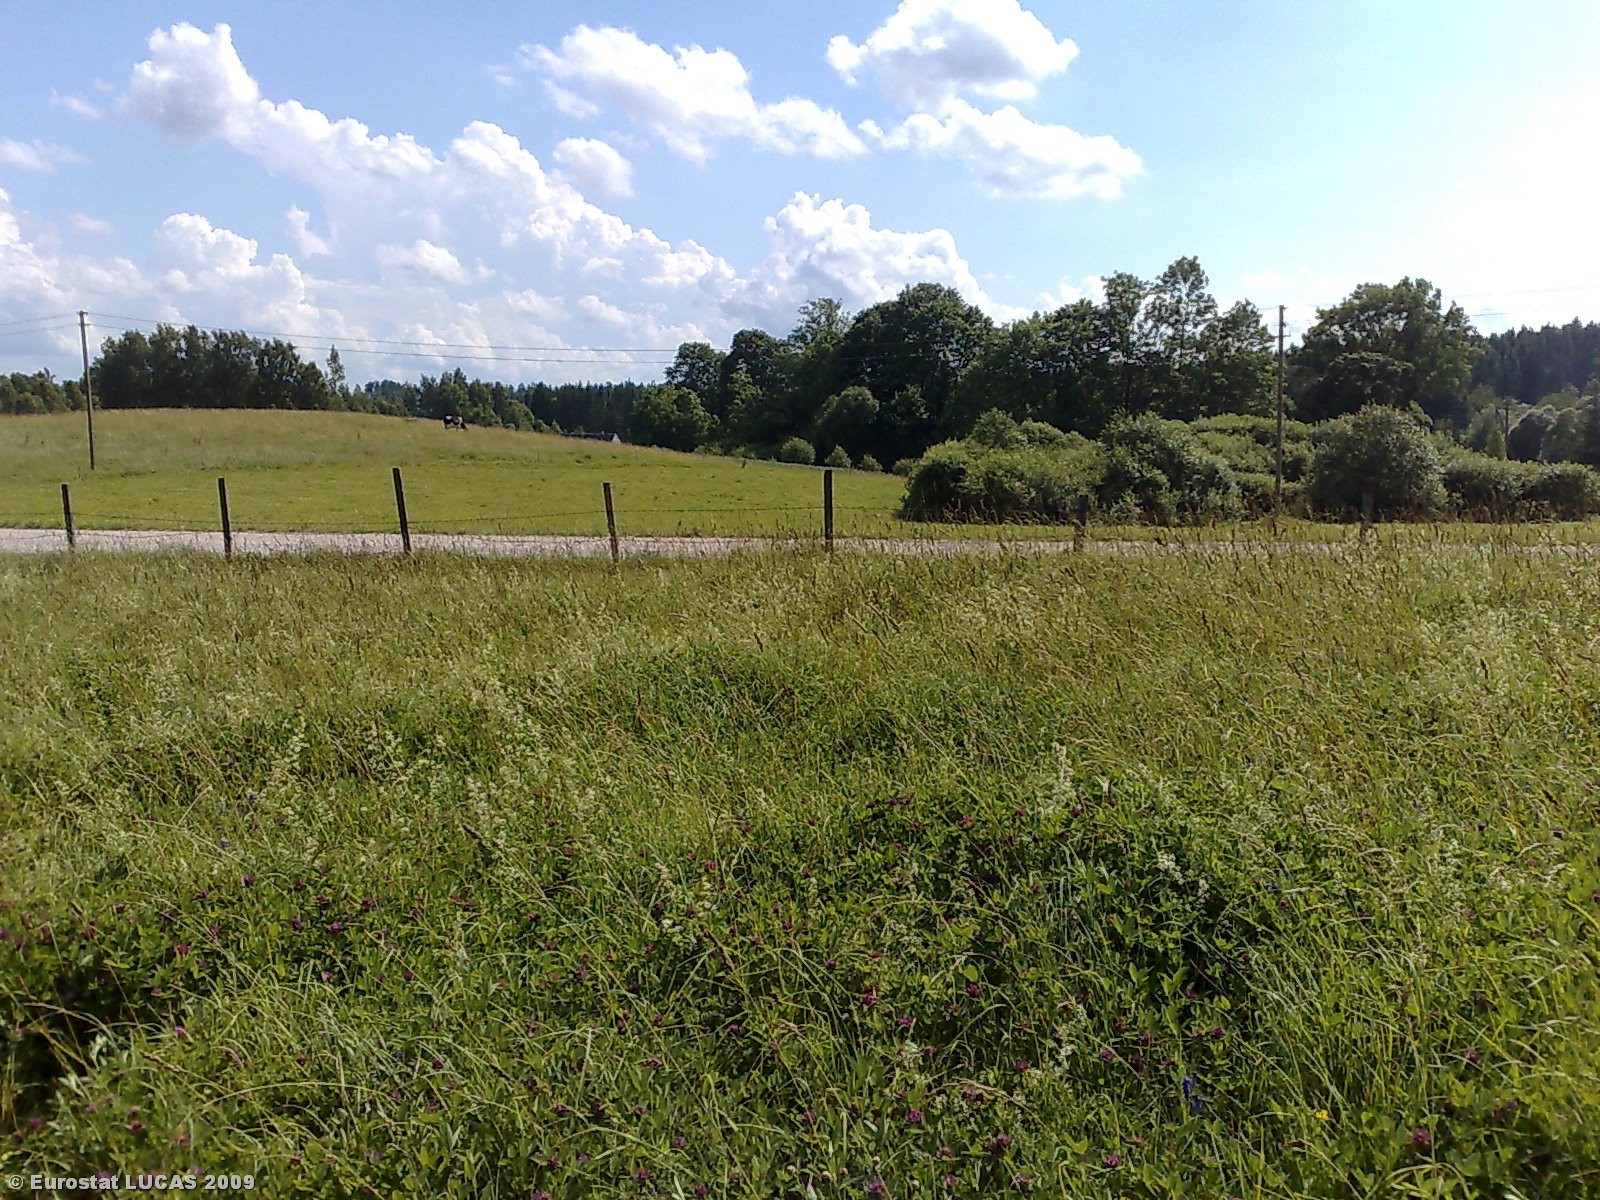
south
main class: Grassland
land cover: Grassland without tree/shrub cover
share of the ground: > 75 %
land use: Agriculture (excluding fallow land and kitchen gardens)
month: July
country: LT
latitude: 55.5681
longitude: 22.7354
